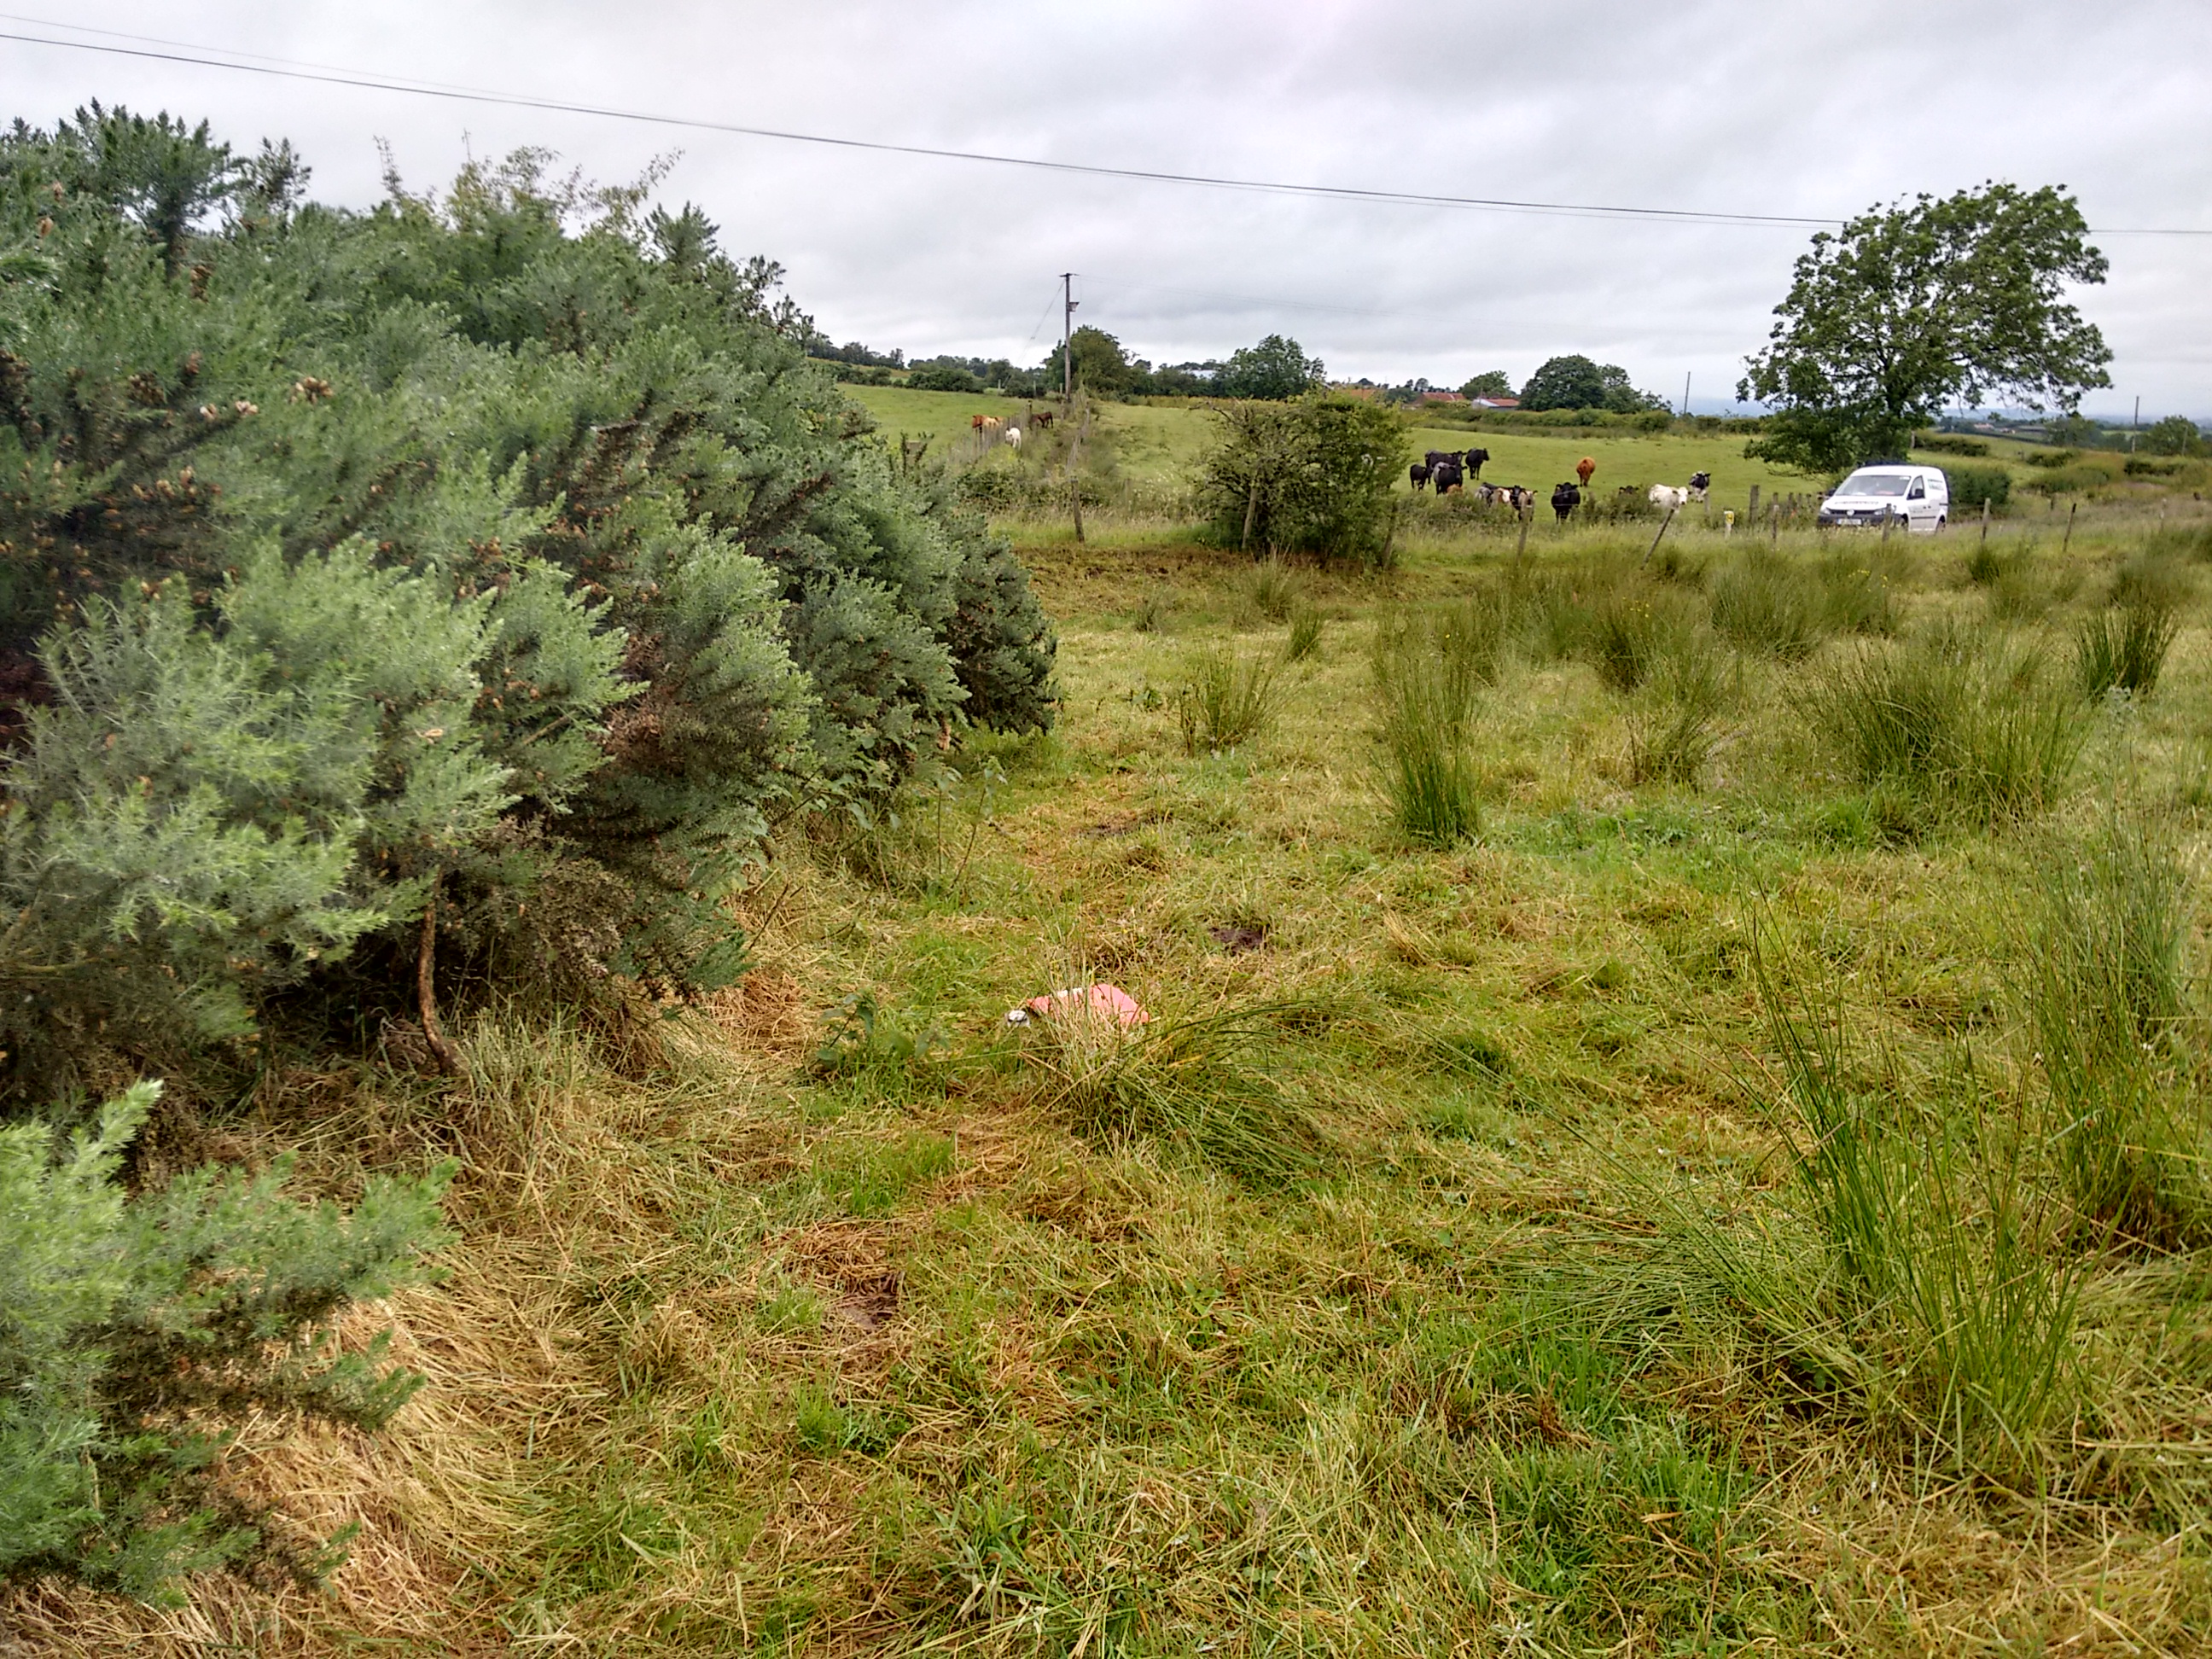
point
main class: Grassland
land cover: Grassland without tree/shrub cover
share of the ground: > 75 %
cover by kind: herbaceous plants 100 %
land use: Agriculture (excluding fallow land and kitchen gardens)
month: July
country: GB
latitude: 54.5214
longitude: -7.1543
